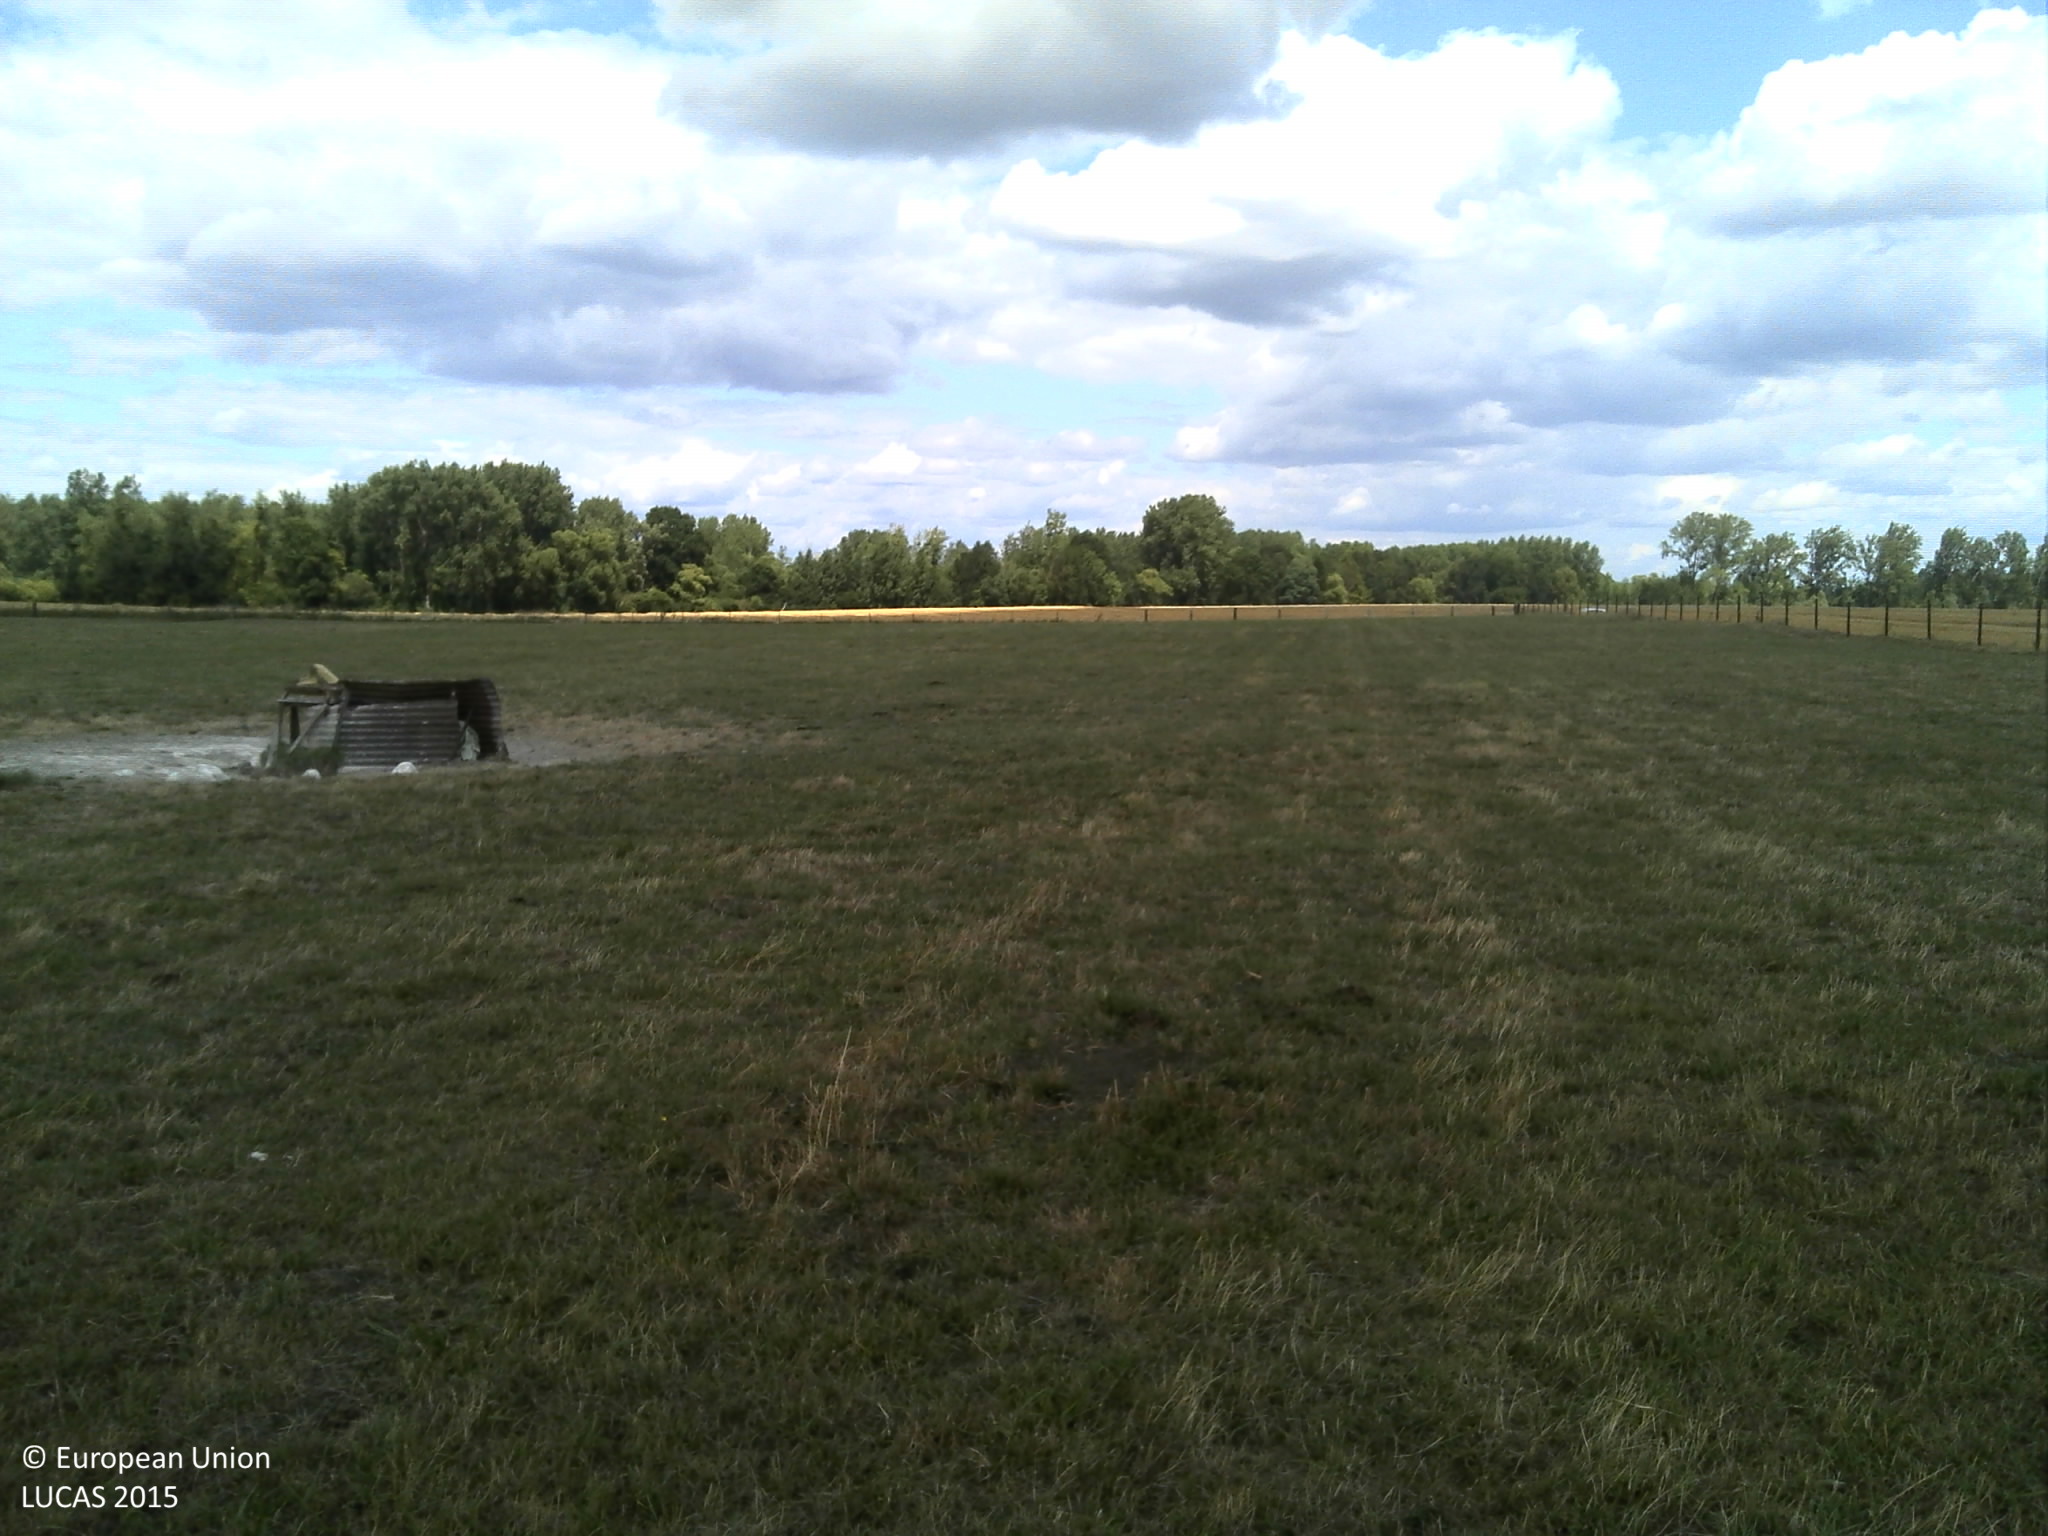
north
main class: Grassland
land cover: Grassland without tree/shrub cover
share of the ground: > 75 %
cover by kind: herbaceous plants 100 %
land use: Agriculture (excluding fallow land and kitchen gardens)
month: July
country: FR
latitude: 49.3566
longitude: 4.6687
